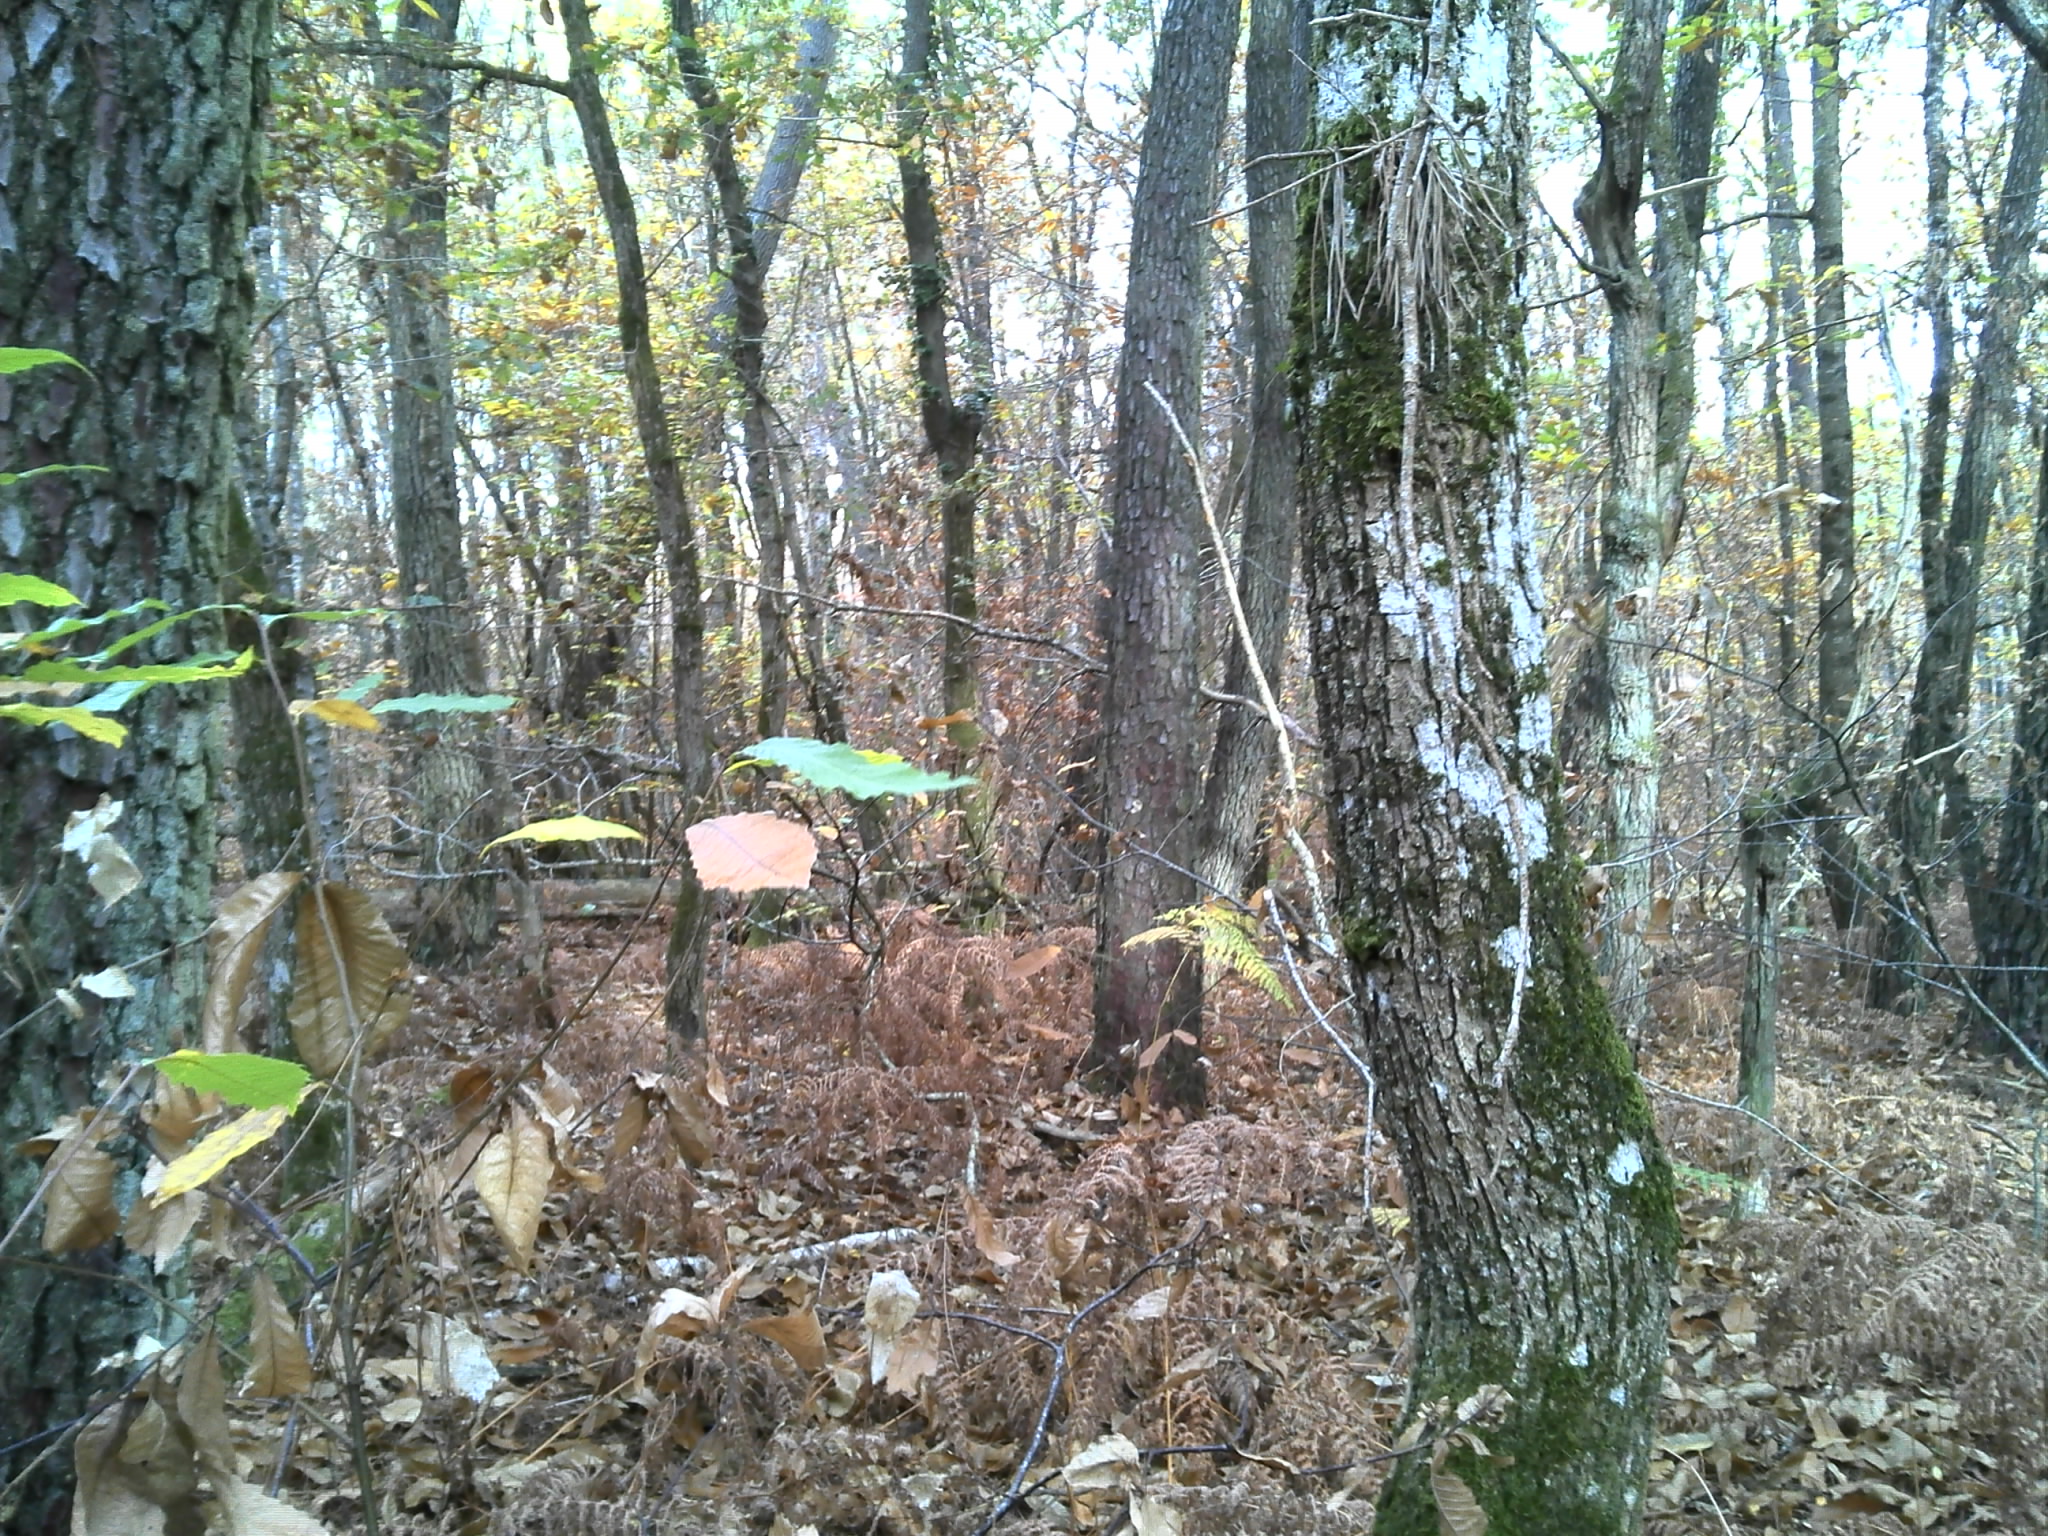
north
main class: Woodland
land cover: Pine dominated mixed woodland
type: hemiboreal forest and nemoral coniferous forest and mixed broadleaved-coniferous forest
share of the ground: > 75 %
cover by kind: broadleaved forest trees 65 %, coniferous forest trees 30 %, herbaceous plants 5 %
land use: Forestry
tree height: > 5 m
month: November
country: FR
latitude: 47.3537
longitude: 0.0328
